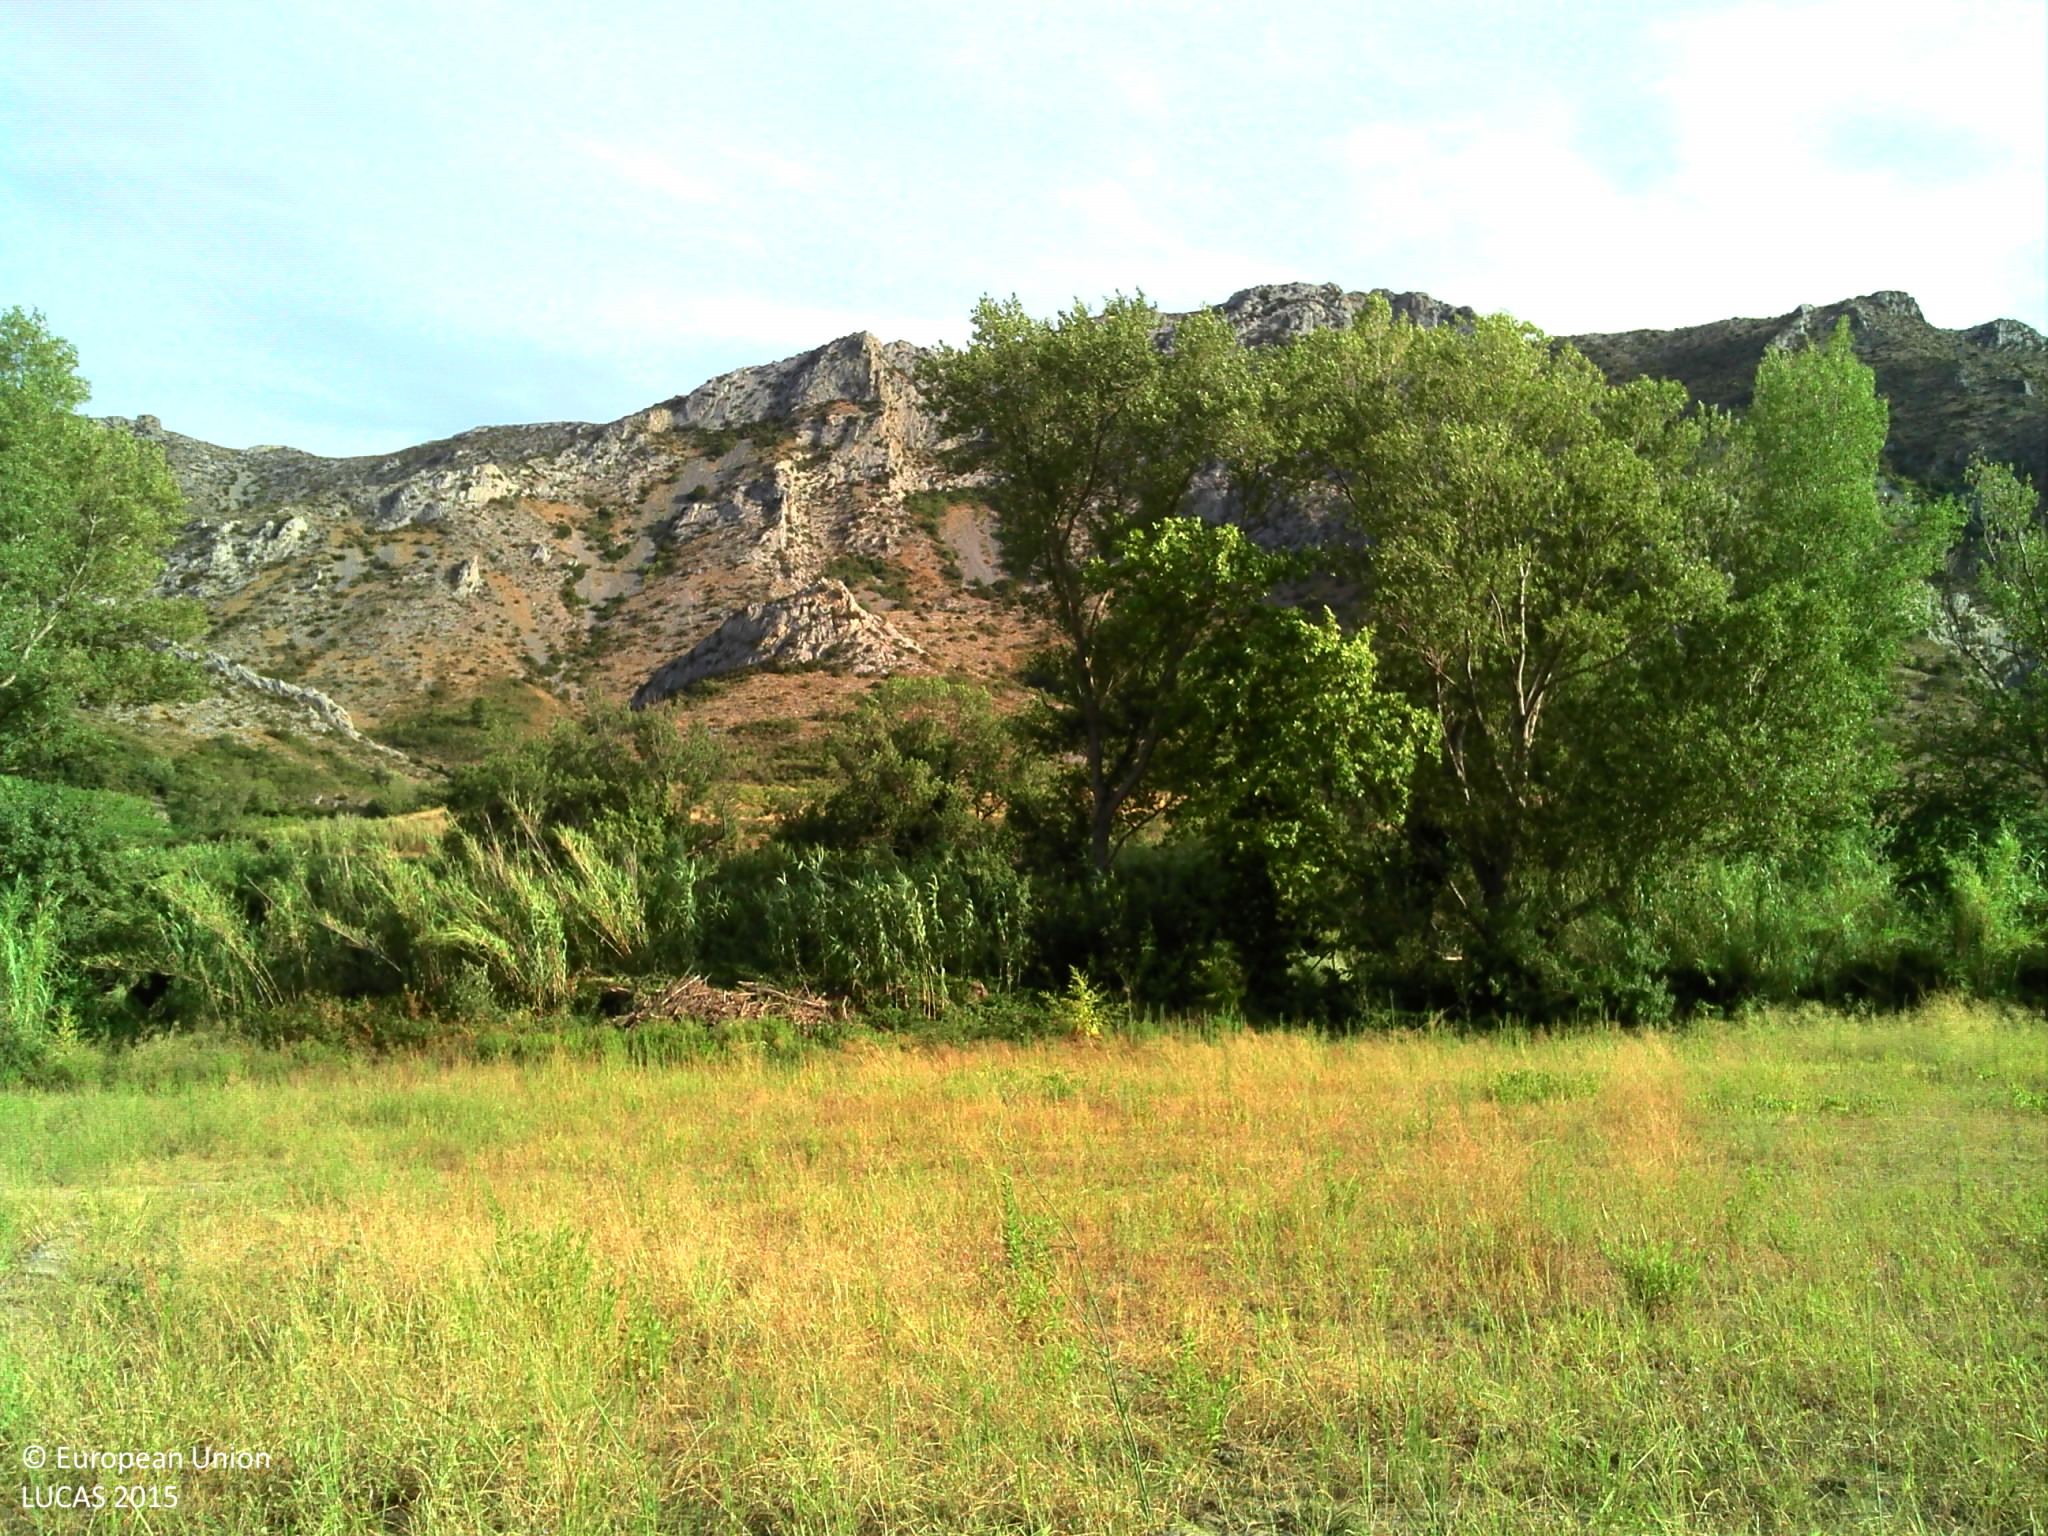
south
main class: Grassland
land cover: Spontaneously vegetated surfaces
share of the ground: > 75 %
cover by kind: unconsolidated bare surface 70 %, herbaceous plants 30 %
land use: Fallow land
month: July
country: FR
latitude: 42.7756
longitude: 2.7634
